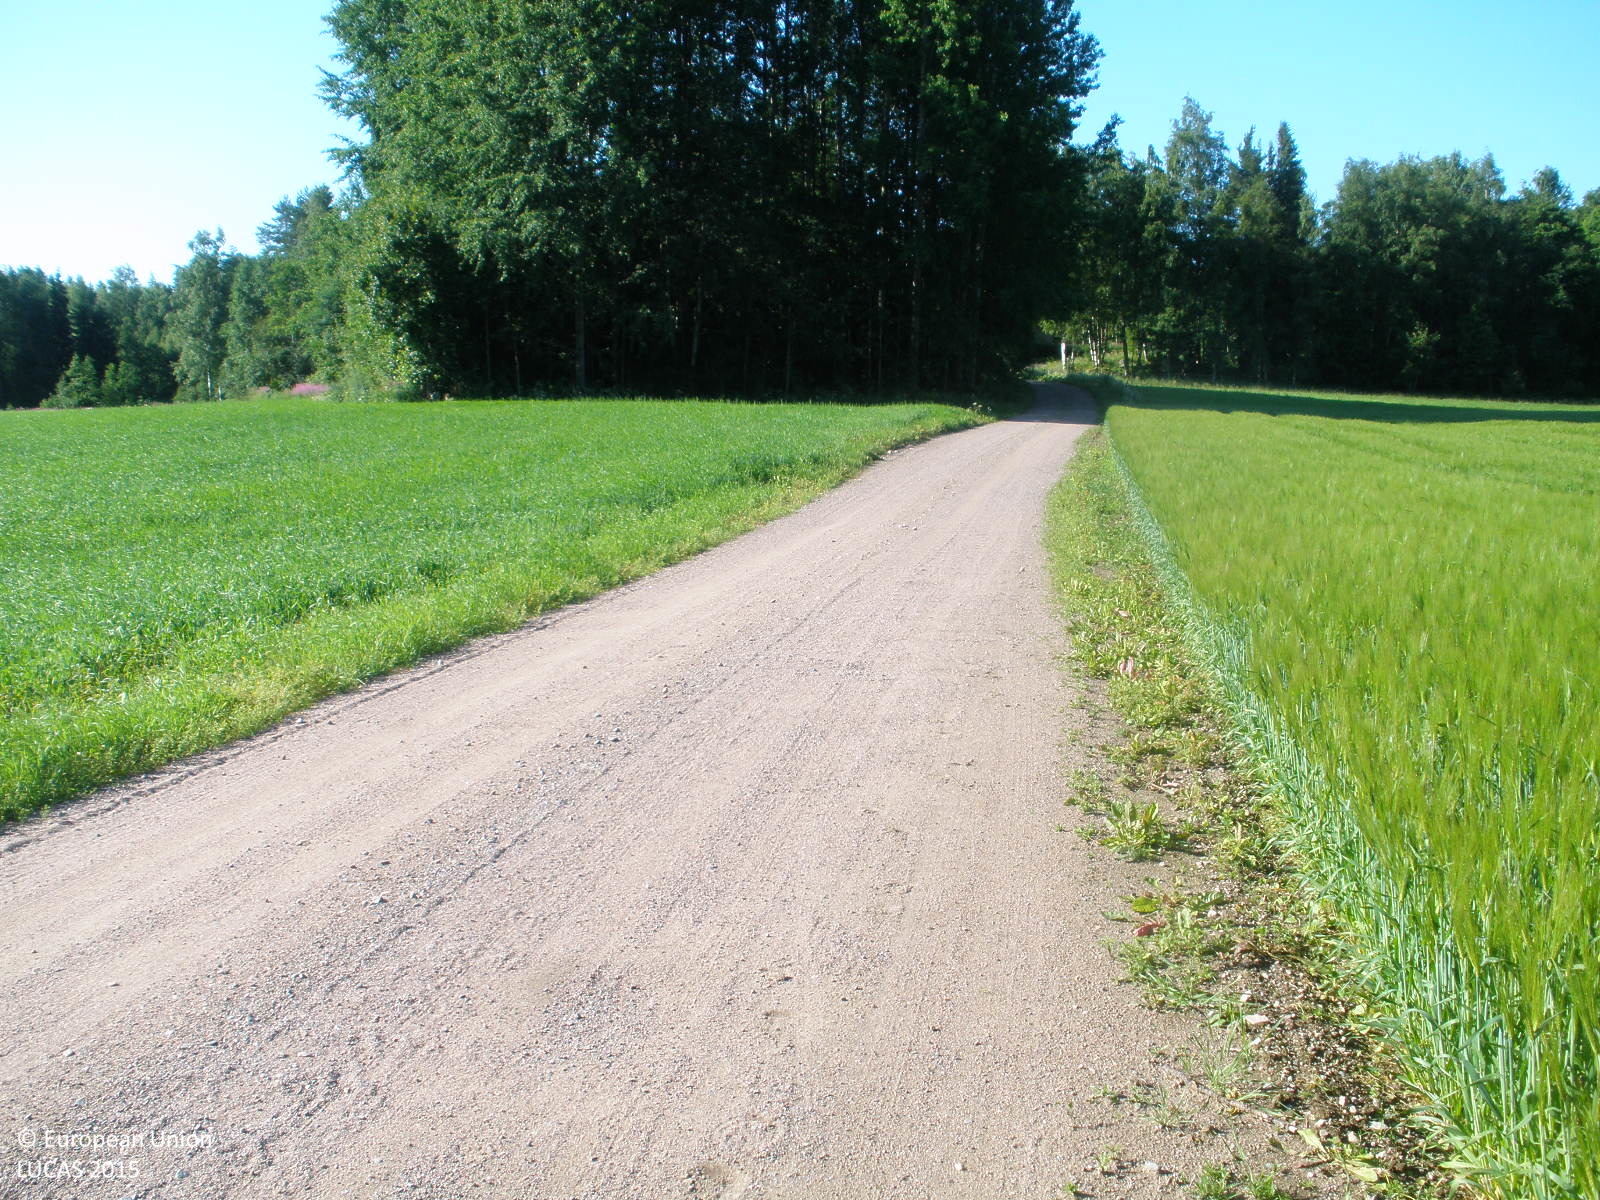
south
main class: Cropland
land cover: Barley
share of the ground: > 75 %
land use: Agriculture (excluding fallow land and kitchen gardens)
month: July
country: FI
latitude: 61.0100
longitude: 25.1548
